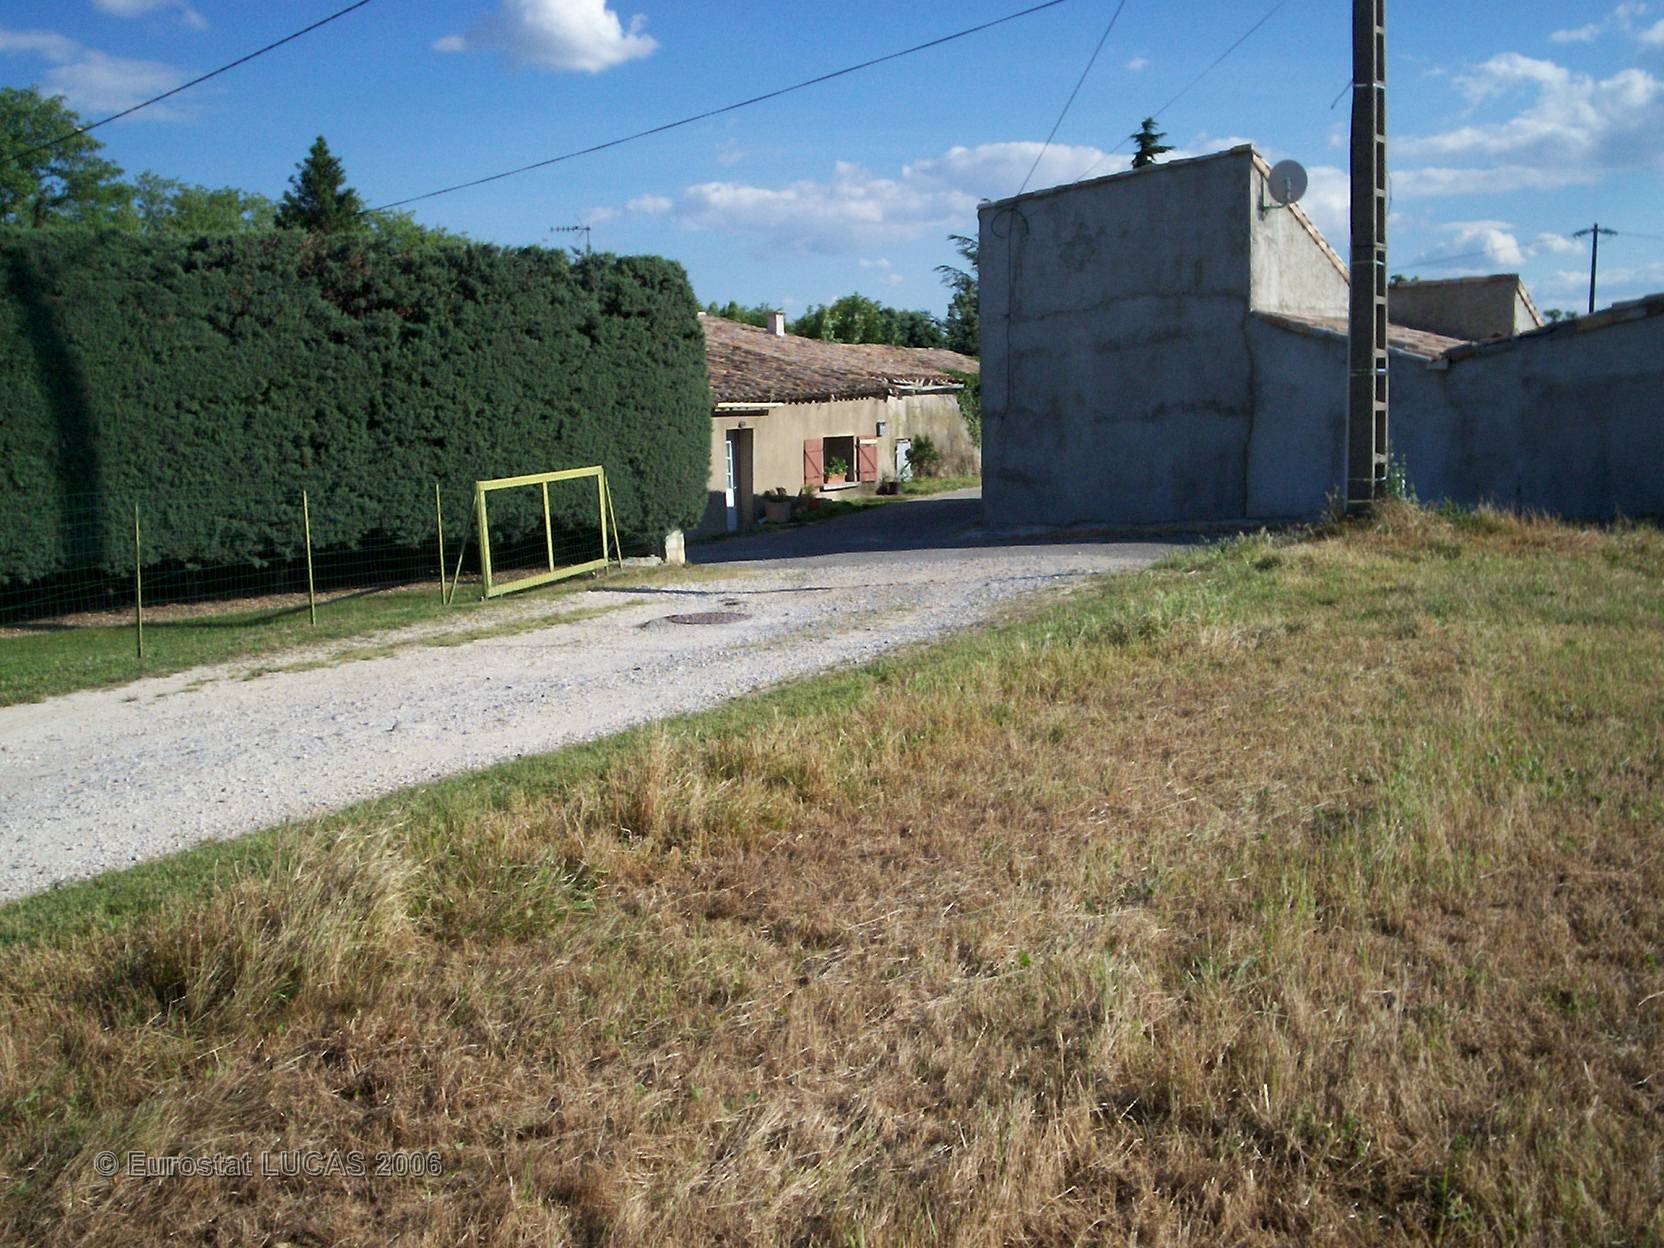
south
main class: Grassland
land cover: Grassland without tree/shrub cover
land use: Agriculture (excluding fallow land and kitchen gardens)
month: May
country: FR
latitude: 44.7269
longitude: 4.8169
